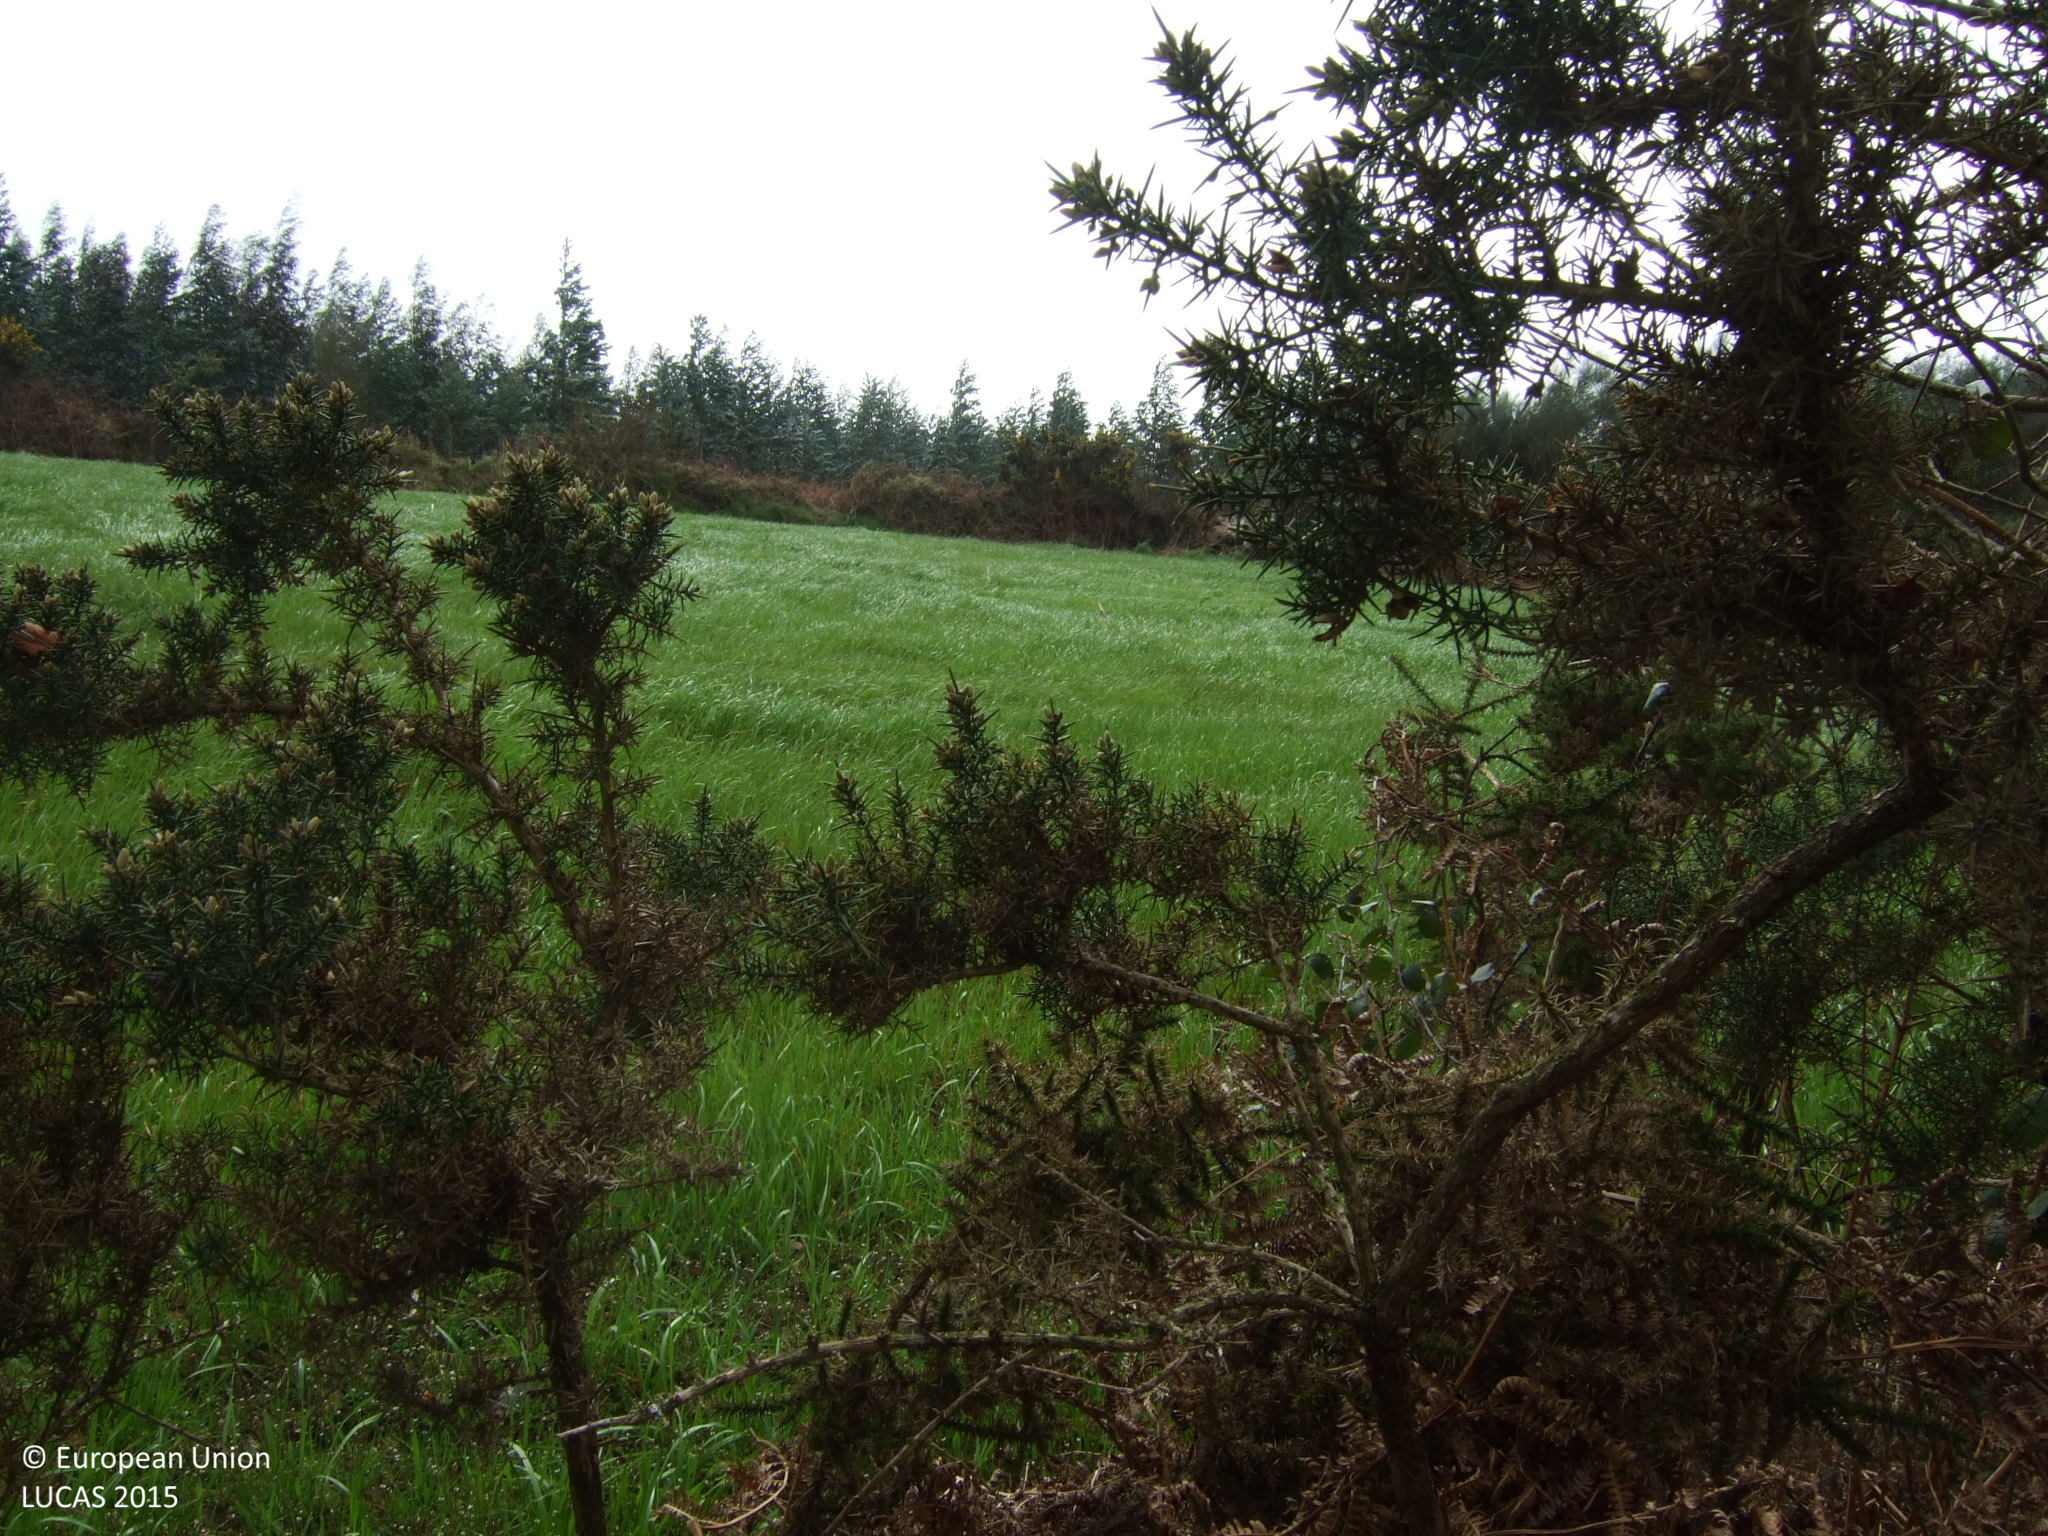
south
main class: Woodland
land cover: Broadleaved woodland
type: acidophilous oak and oak-birch forest
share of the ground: > 75 %
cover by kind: broadleaved forest trees 80 %, shrubs 20 %
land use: Semi-natural and natural areas not in use
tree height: > 5 m
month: March
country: ES
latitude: 42.9323
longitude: -7.8645
